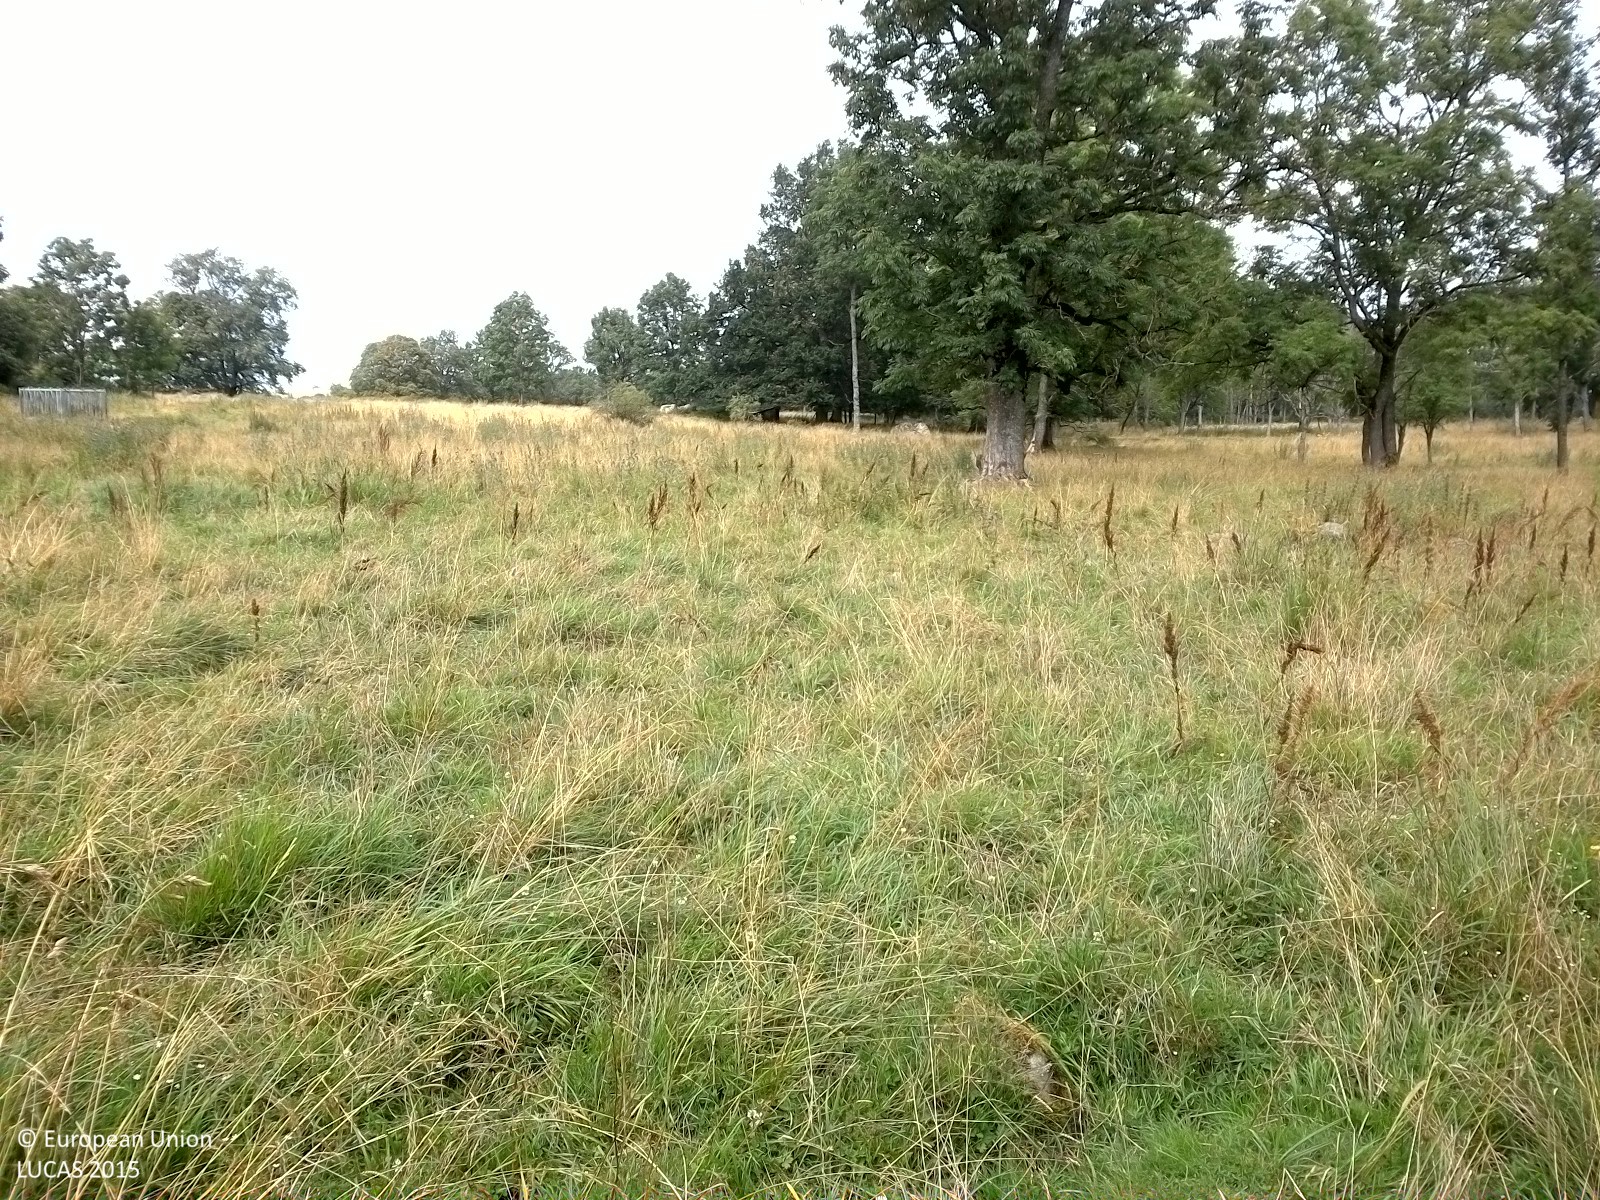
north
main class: Grassland
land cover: Grassland without tree/shrub cover
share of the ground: > 75 %
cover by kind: herbaceous plants 100 %
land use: Agriculture (excluding fallow land and kitchen gardens)
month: August
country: SE
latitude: 59.1204
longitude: 14.9356
